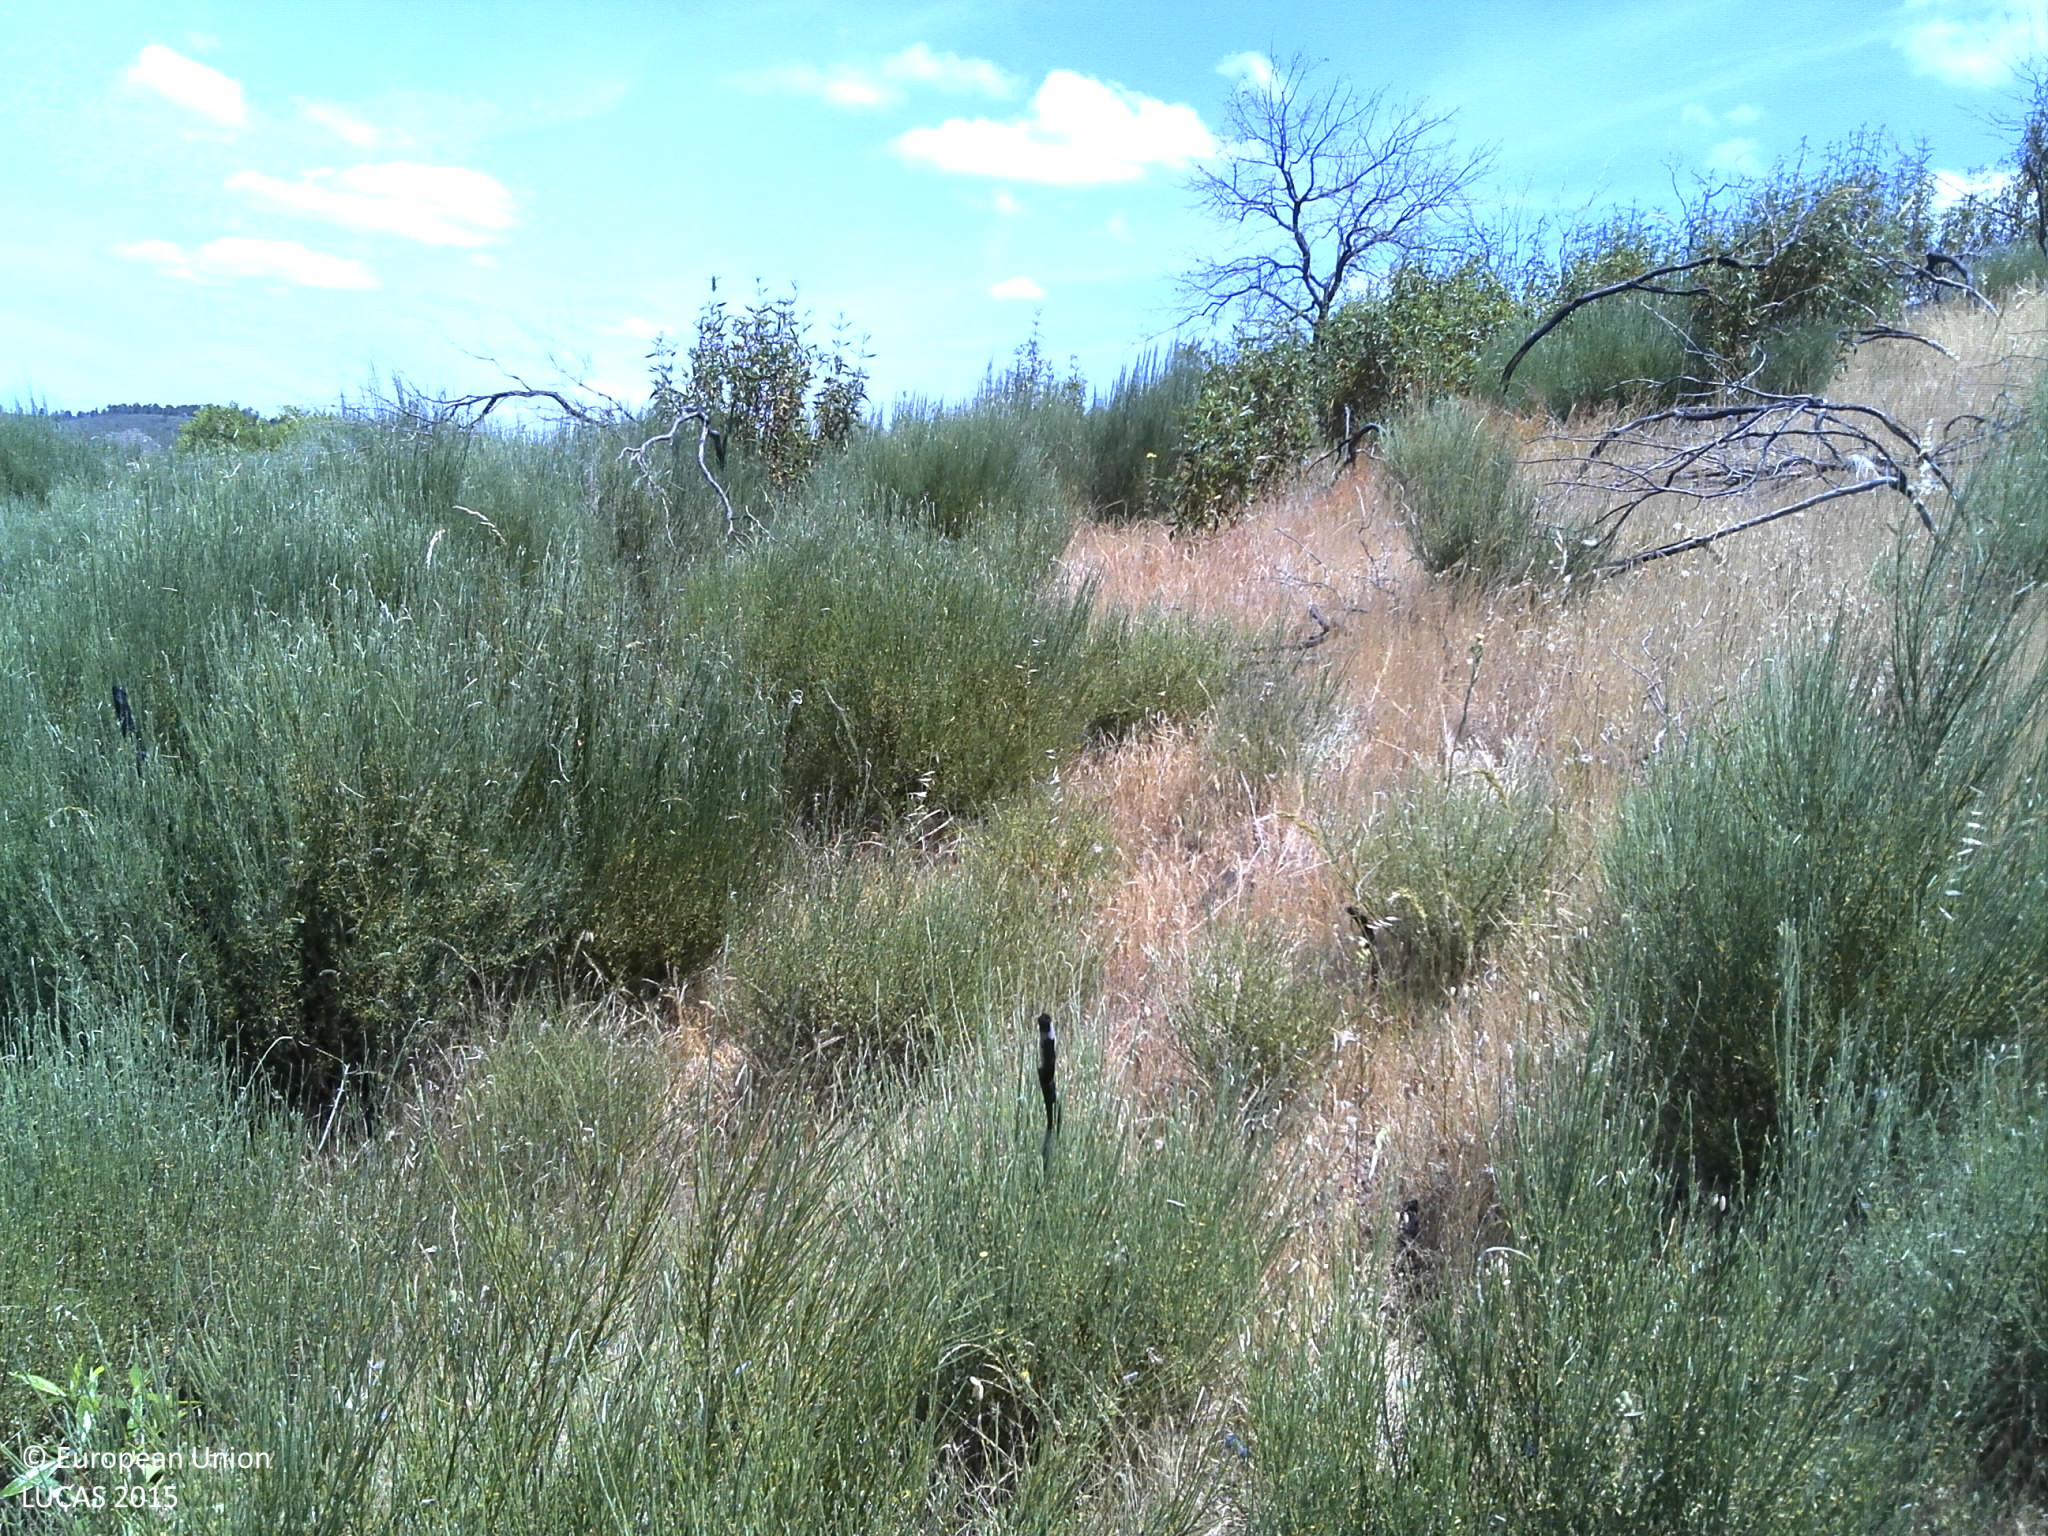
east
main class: Shrubland
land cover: Shrubland with sparse tree cover
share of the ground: 50 - 75 %
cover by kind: shrubs 75 %, herbaceous plants 10 %, unconsolidated bare surface 10 %, broadleaved forest trees 5 %
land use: Abandoned areas
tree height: < 5 m
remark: Burnt area
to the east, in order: Shrubland with sparse tree cover
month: May
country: PT
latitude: 41.1409
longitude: -6.9420
